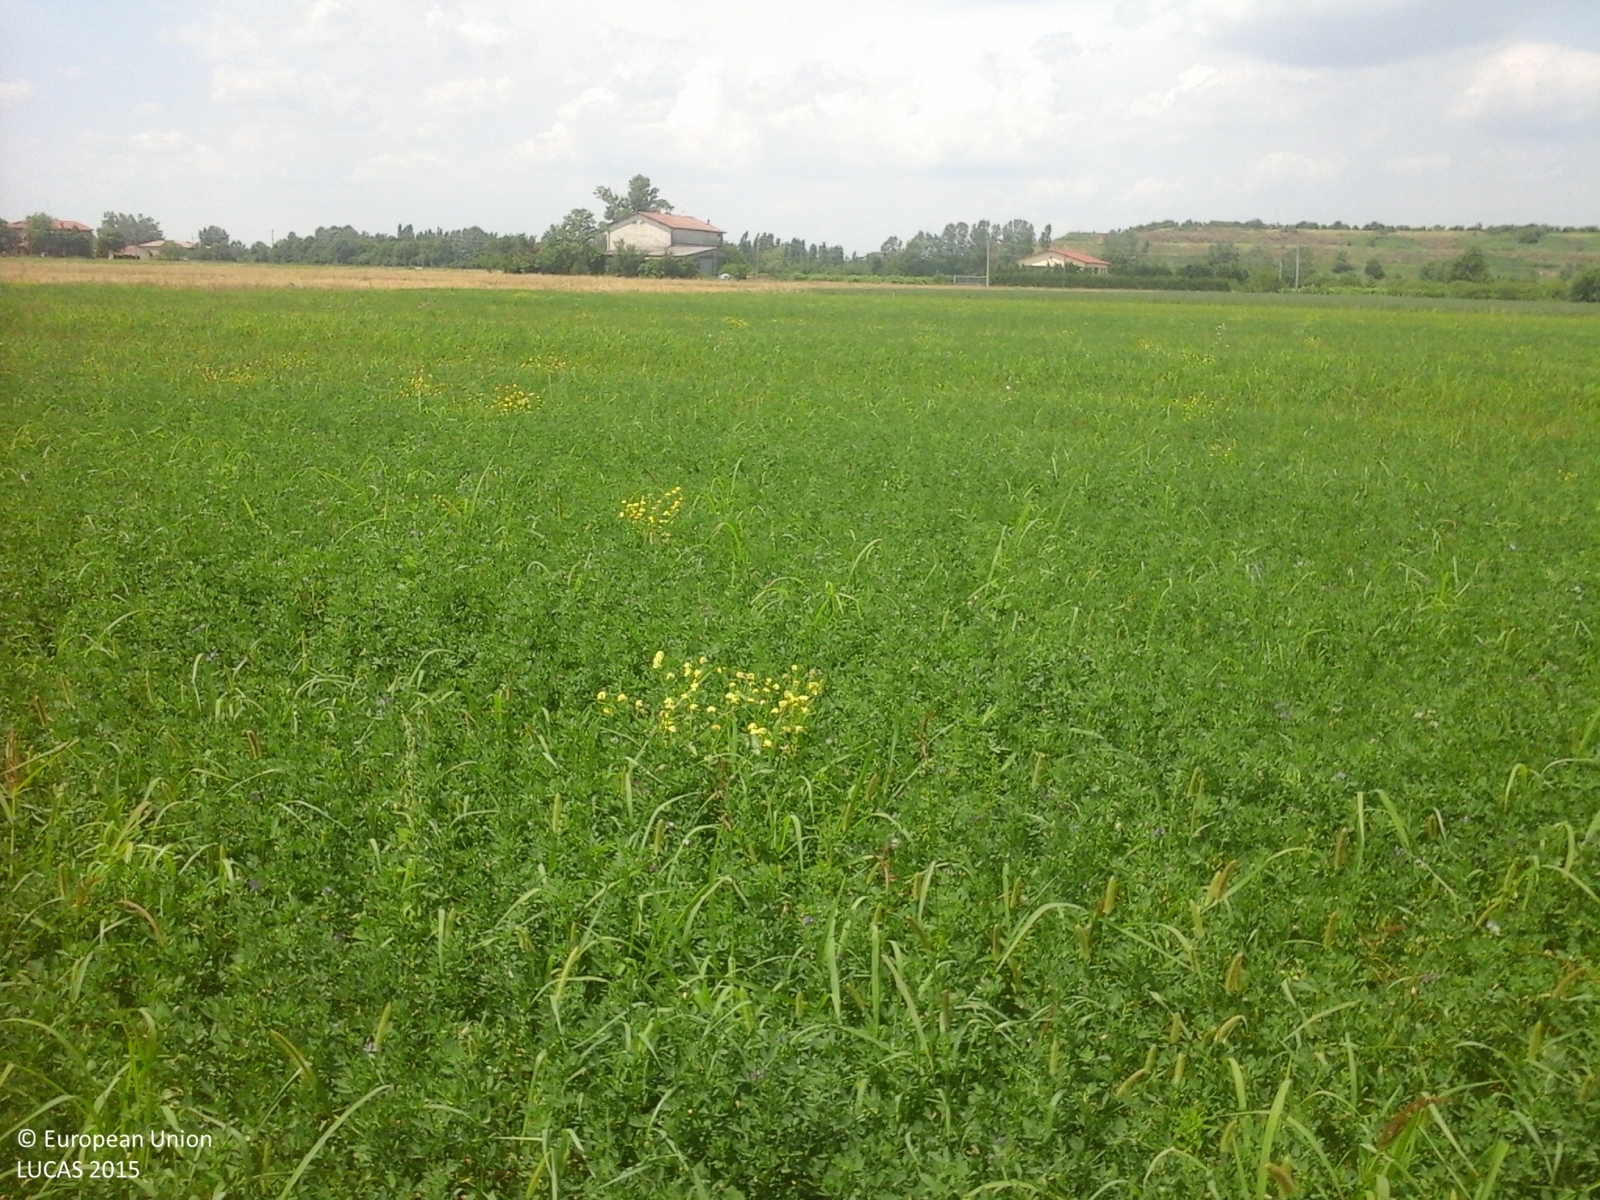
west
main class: Cropland
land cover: Lucerne
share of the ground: > 75 %
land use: Agriculture (excluding fallow land and kitchen gardens)
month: June
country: IT
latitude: 44.8154
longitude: 10.9212
